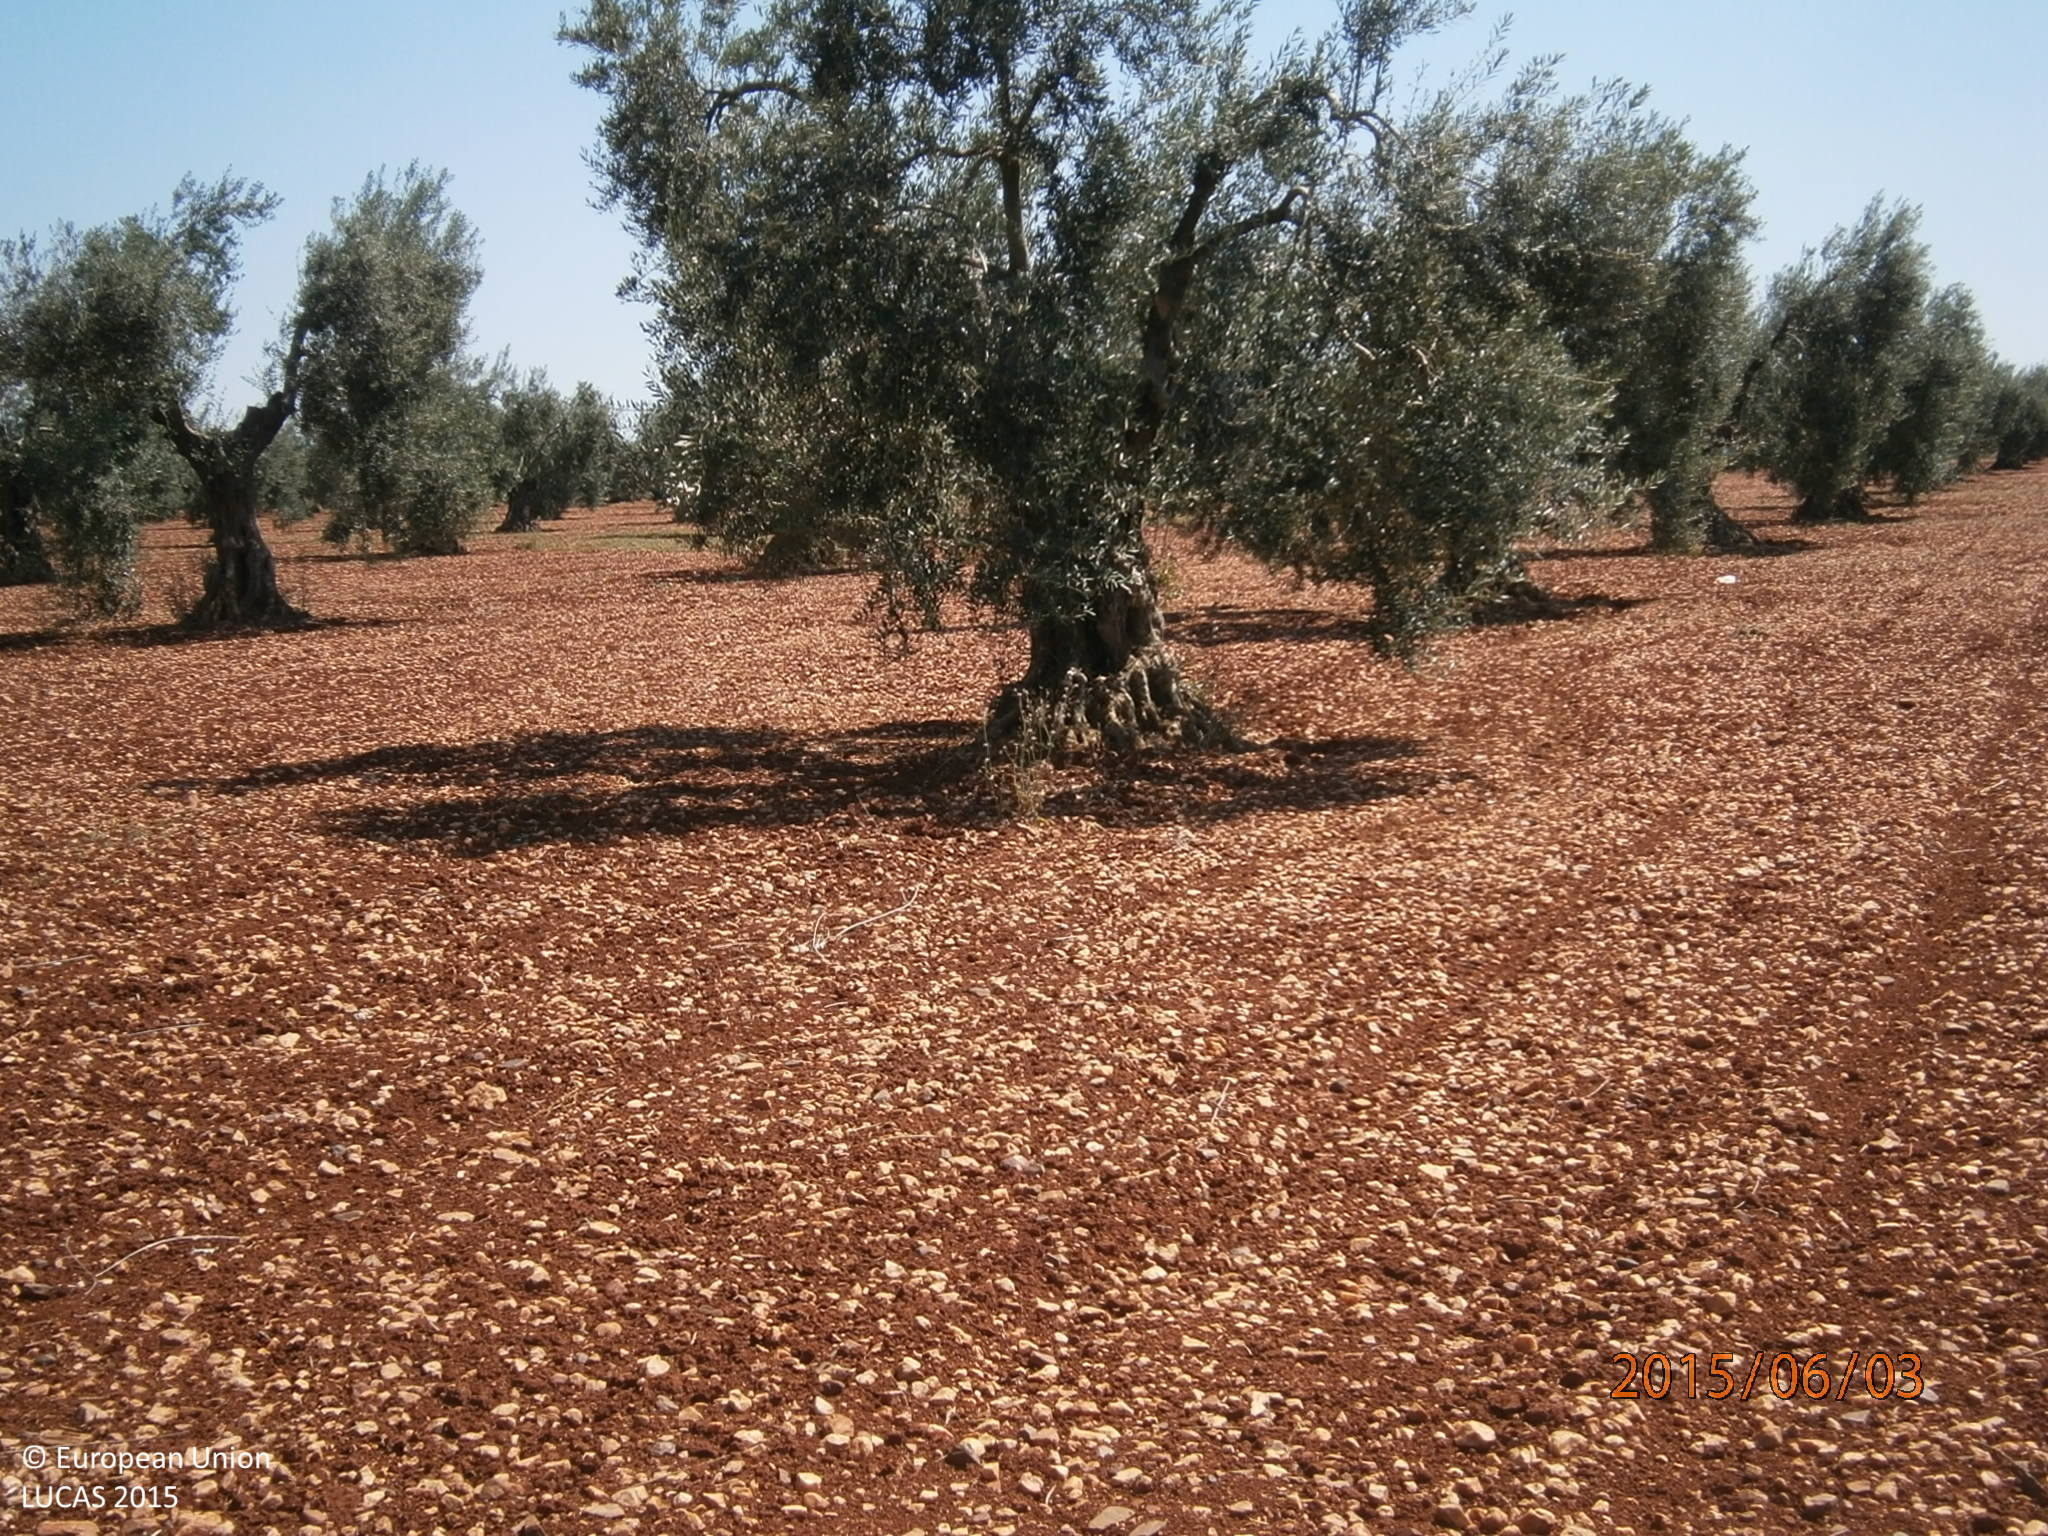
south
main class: Cropland
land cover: Olive groves
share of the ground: 10 - 25 %
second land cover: Other bare soil
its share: > 75 %
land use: Agriculture (excluding fallow land and kitchen gardens)
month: June
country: ES
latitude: 38.6330
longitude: -6.4240
